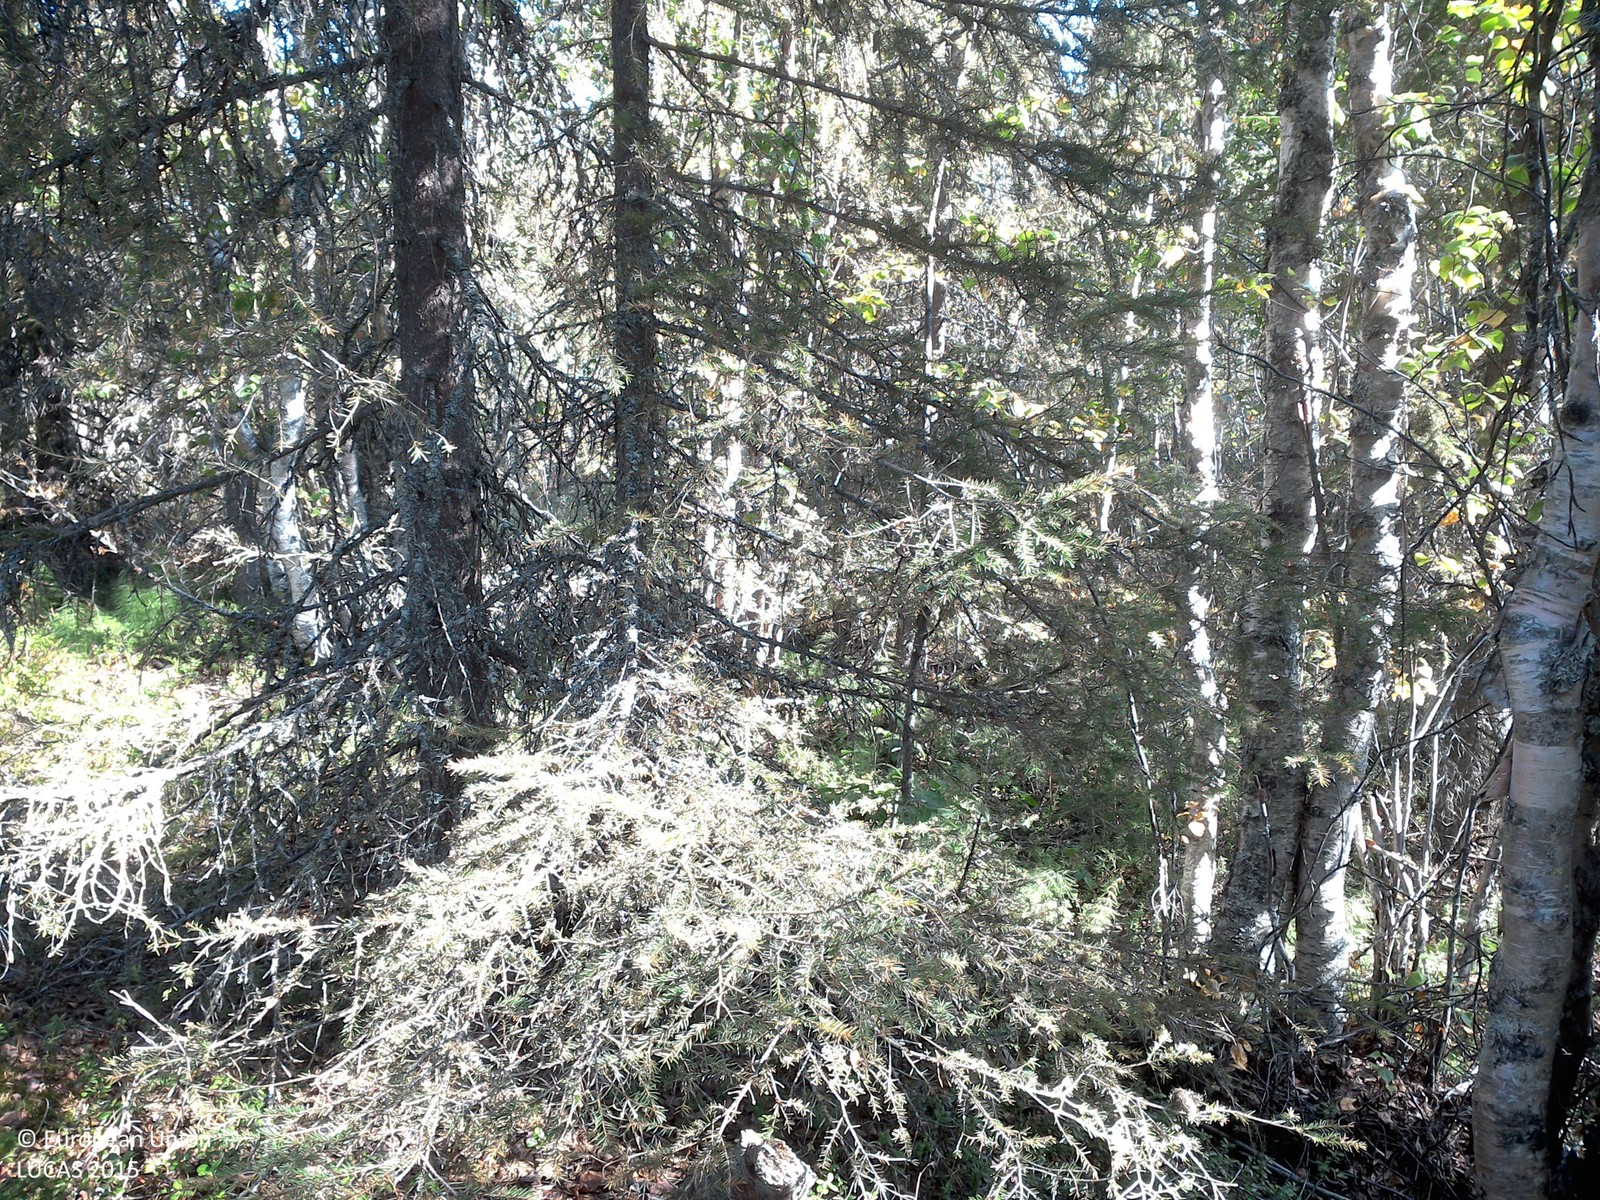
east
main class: Woodland
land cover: Pine dominated coniferous woodland
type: boreal forest
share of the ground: 25 - 50 %
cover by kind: shrubs 50 %, coniferous forest trees 35 %, lichens and mosses 15 %
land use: Forestry
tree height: > 5 m
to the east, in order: Pine dominated coniferous woodland; Spruce dominated mixed woodland; Other mixed woodland; Pine dominated coniferous woodland; Pine dominated mixed woodland; Spruce dominated mixed woodland; Rivers and streams; Pine dominated mixed woodland
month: August
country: SE
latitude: 67.0420
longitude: 21.9749
